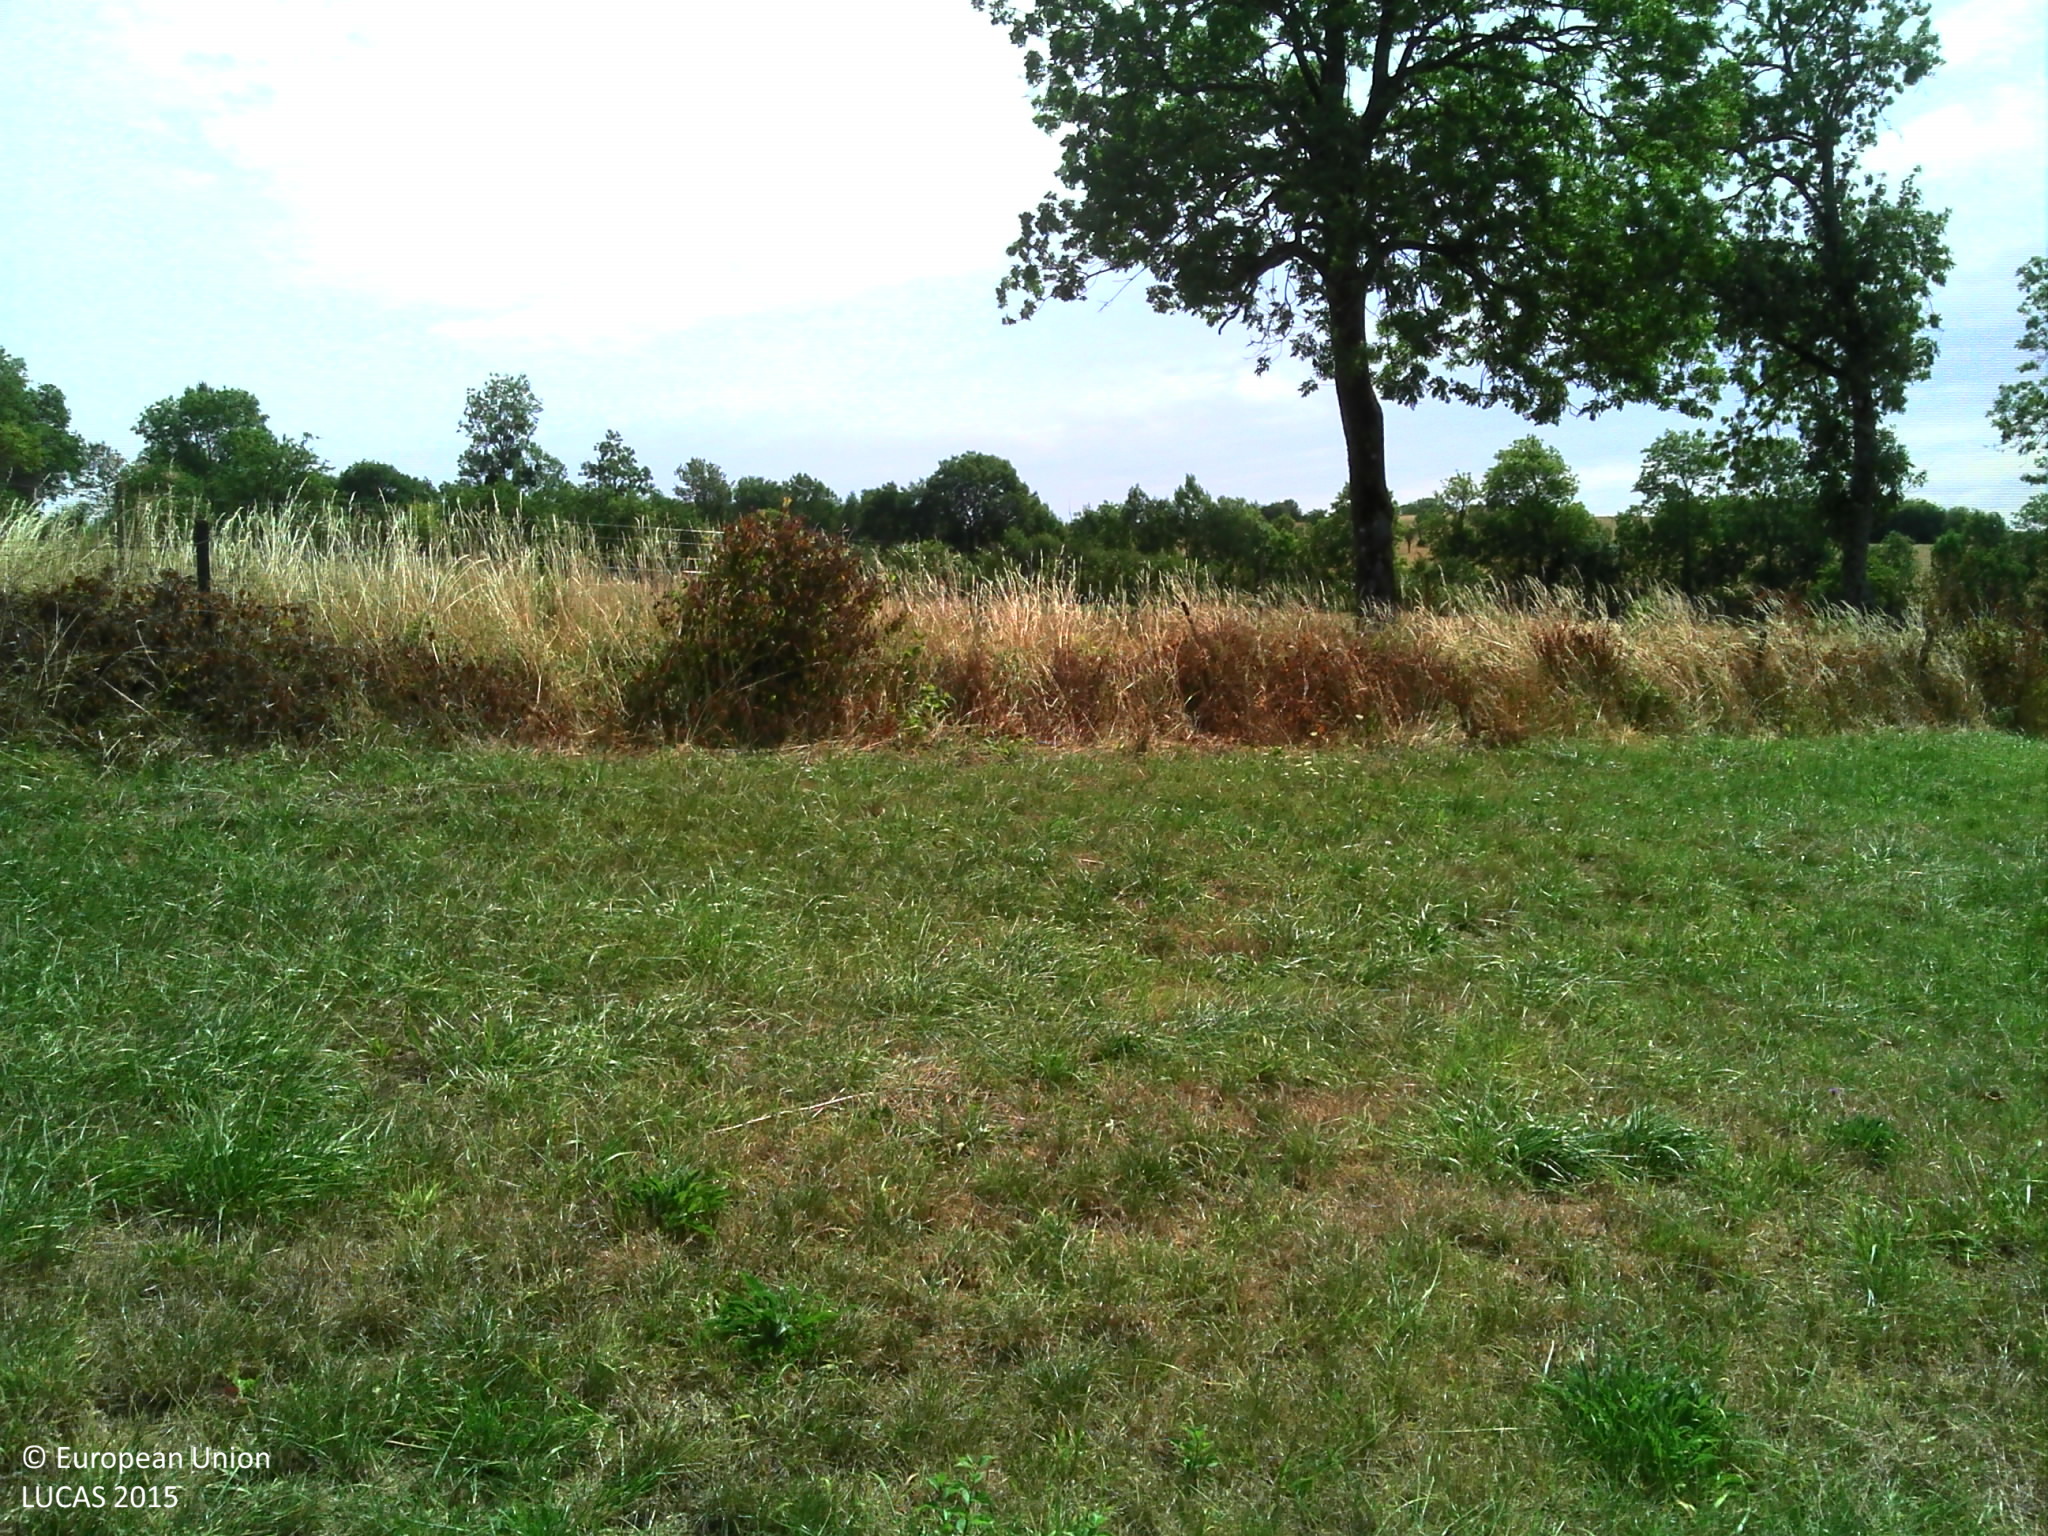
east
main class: Grassland
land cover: Grassland with sparse tree/shrub cover
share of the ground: > 75 %
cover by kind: herbaceous plants 95 %, broadleaved forest trees 5 %
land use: Agriculture (excluding fallow land and kitchen gardens)
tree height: > 5 m
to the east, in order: Grassland with sparse tree/shrub cover; Fences; Grass margins; Paved roads, cycling and walking lanes; Grass margins; Ditches and canals; Grass margins; Fences; Rice; Fences; Grassland with sparse tree/shrub cover; Grassland without tree/shrub cover; Fences; Spontaneously vegetated surfaces; Broadleaved woodland; Fences; Grassland with sparse tree/shrub cover
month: July
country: FR
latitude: 48.4018
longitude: 5.9613
